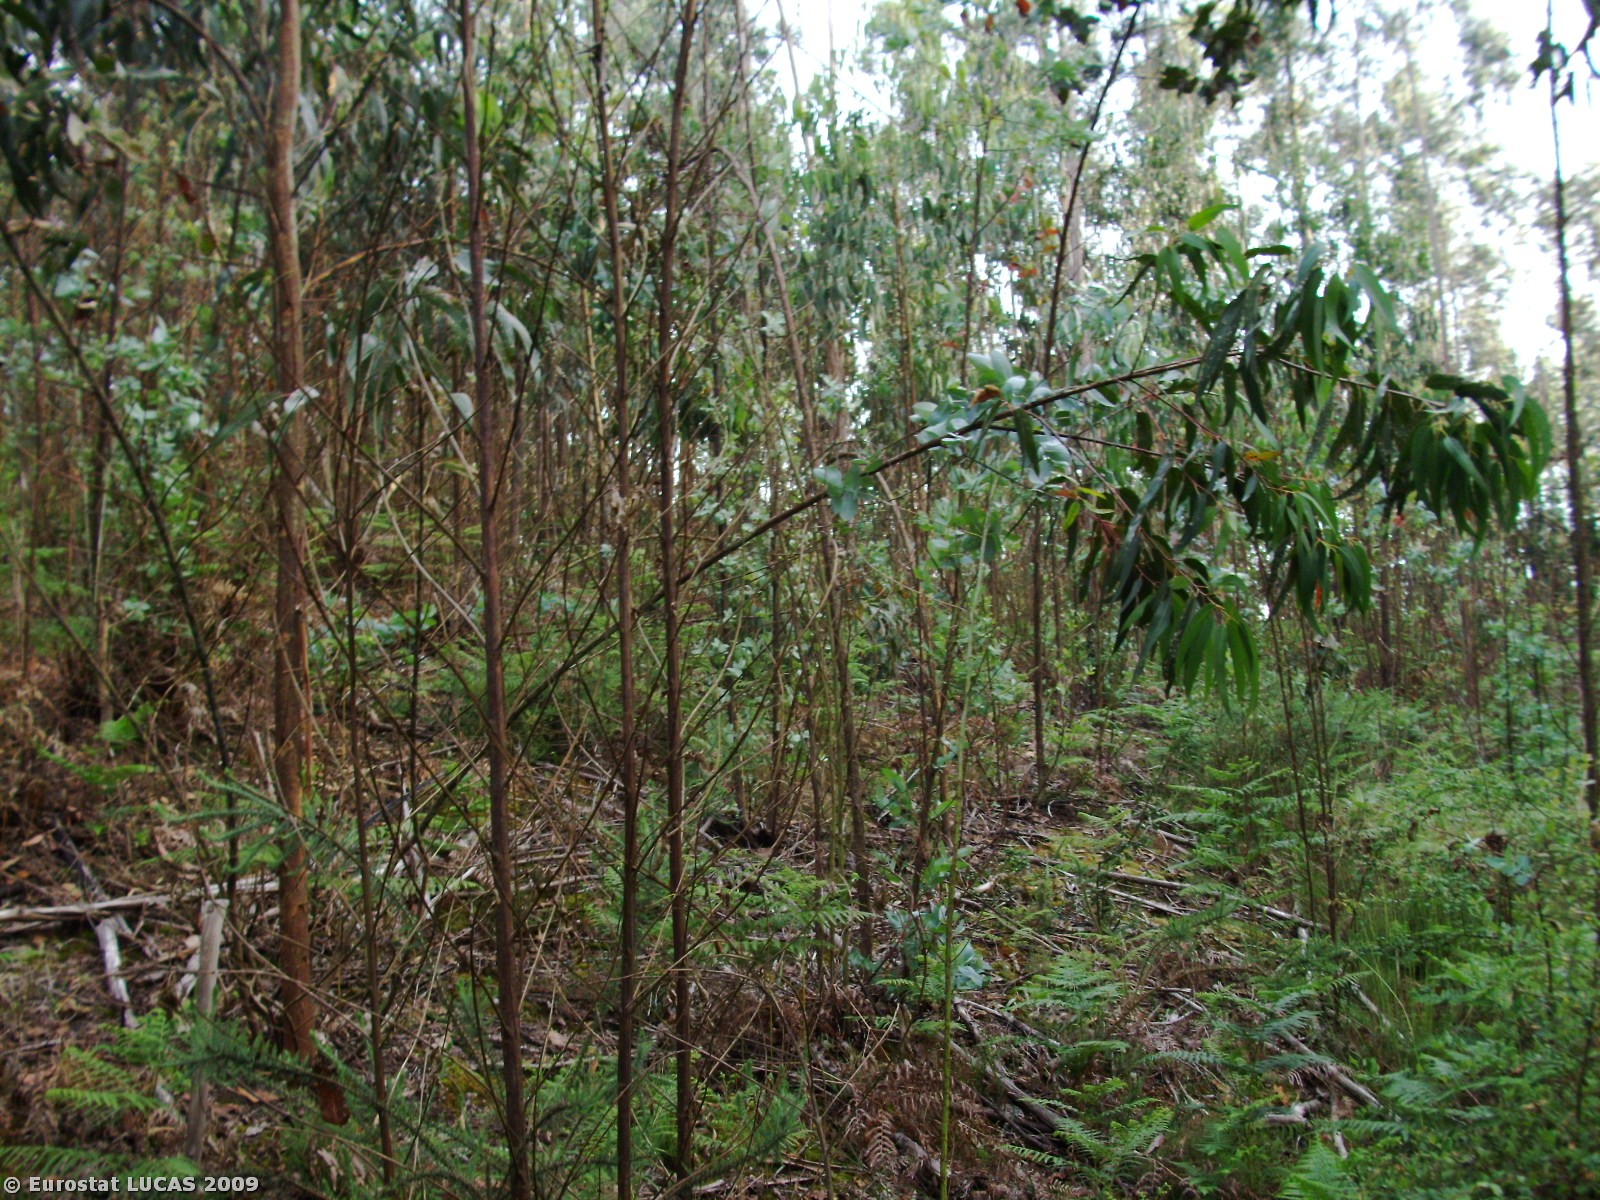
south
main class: Woodland
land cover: Broadleaved woodland
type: plantations and self-sown exotic forest
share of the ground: > 75 %
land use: Forestry
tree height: > 5 m
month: May
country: PT
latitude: 41.0554
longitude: -8.5318
